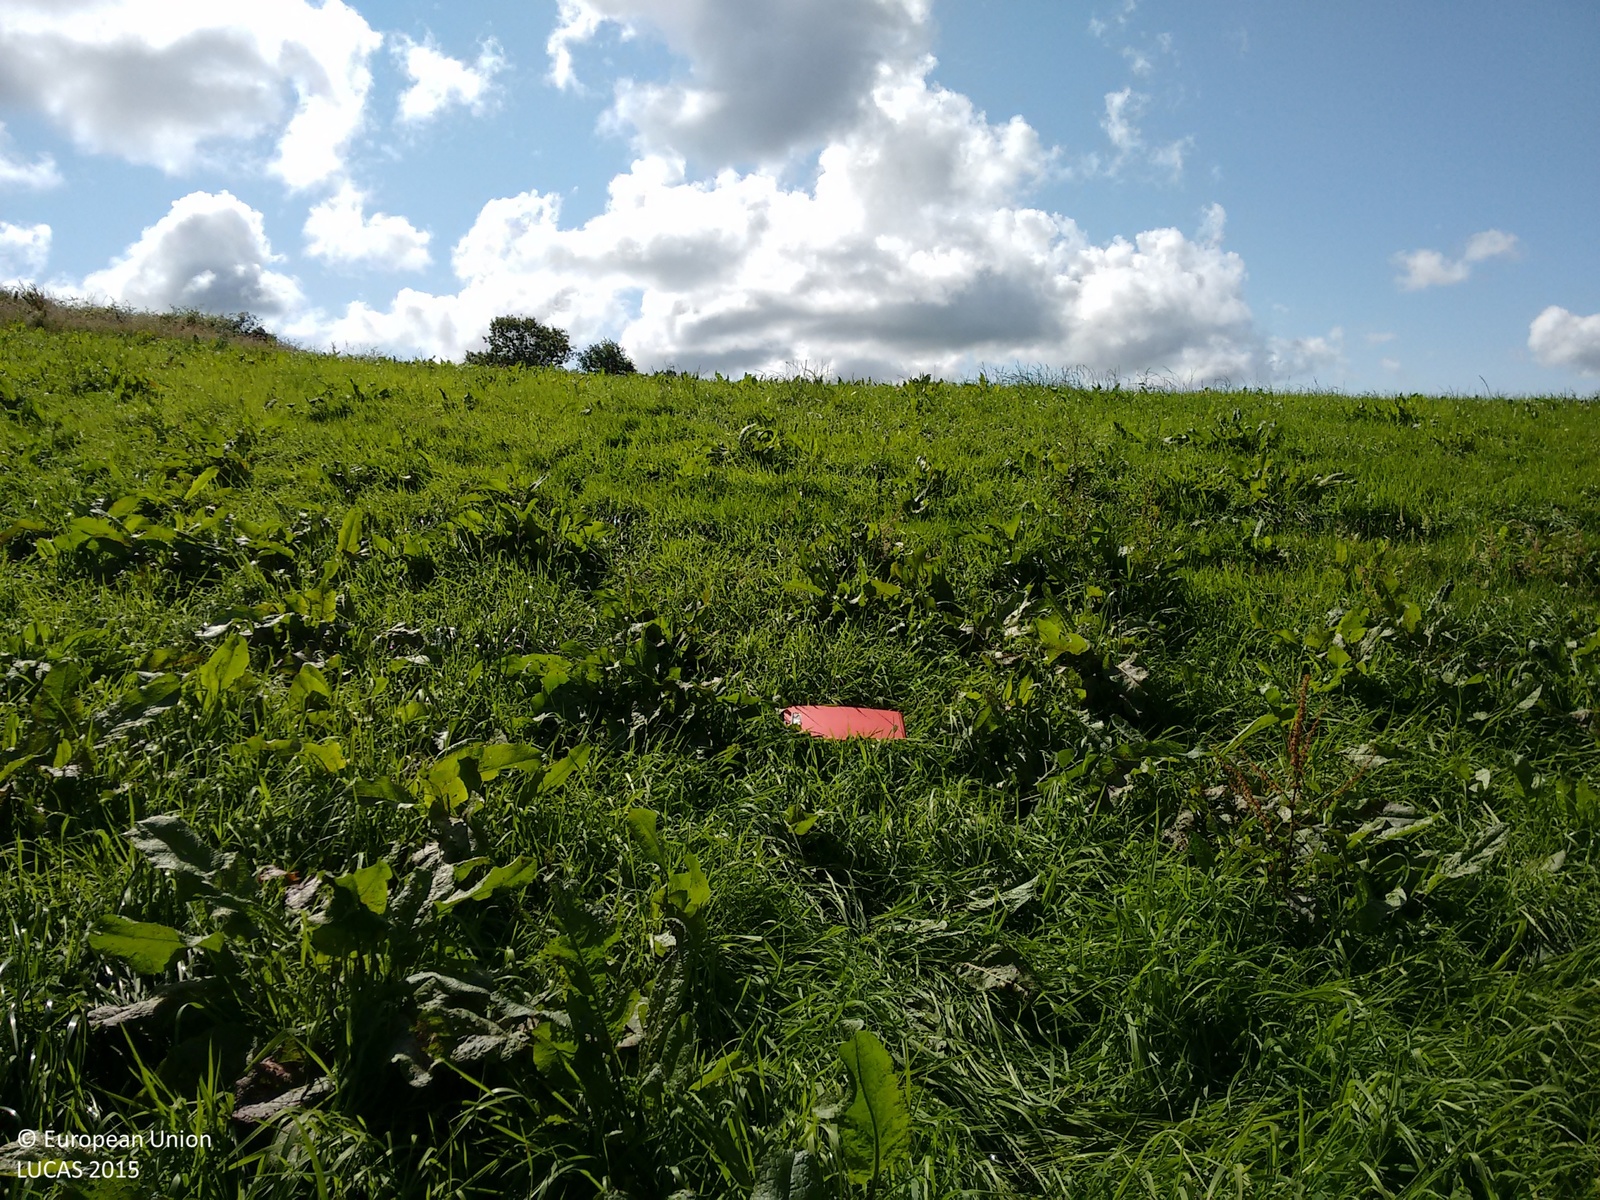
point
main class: Grassland
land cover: Grassland without tree/shrub cover
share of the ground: > 75 %
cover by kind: herbaceous plants 95 %, shrubs 5 %
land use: Agriculture (excluding fallow land and kitchen gardens)
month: July
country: IE
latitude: 52.8407
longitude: -8.4064
